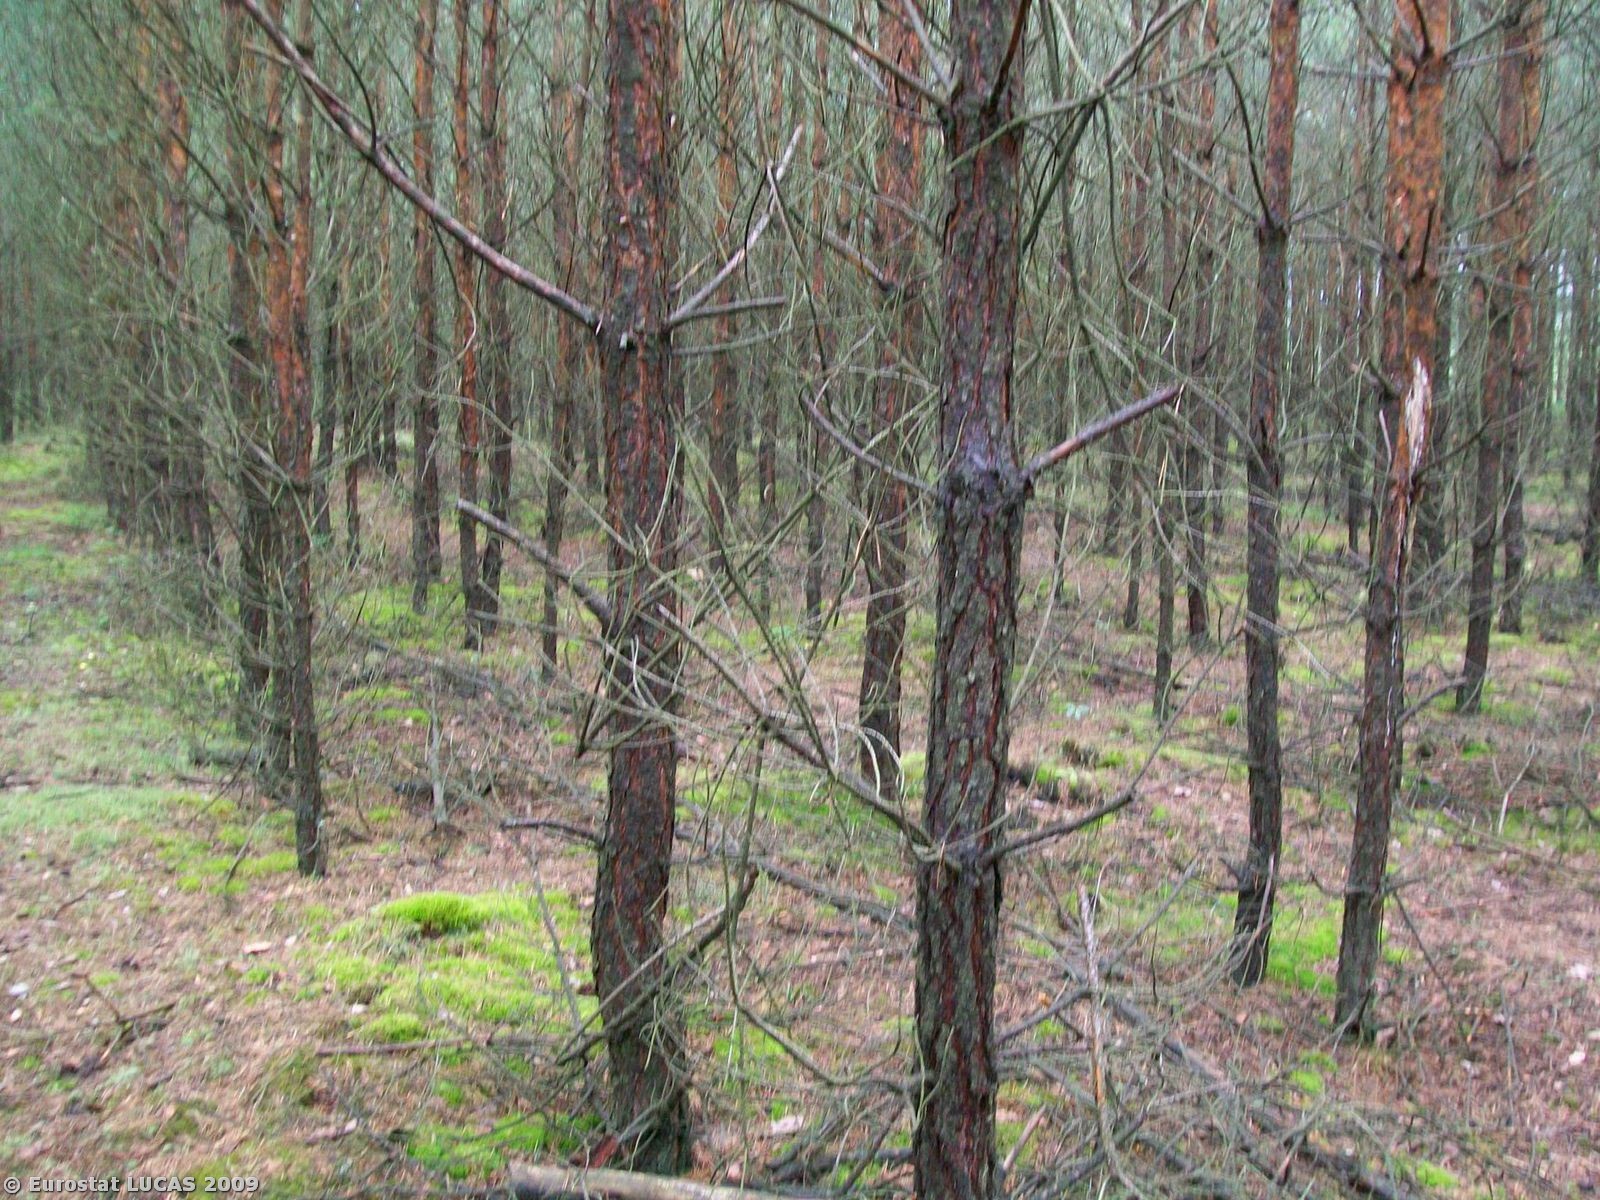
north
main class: Woodland
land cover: Coniferous woodland
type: hemiboreal forest and nemoral coniferous forest and mixed broadleaved-coniferous forest
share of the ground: > 75 %
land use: Forestry
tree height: > 5 m
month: June
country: PL
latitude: 51.3826
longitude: 15.1616
